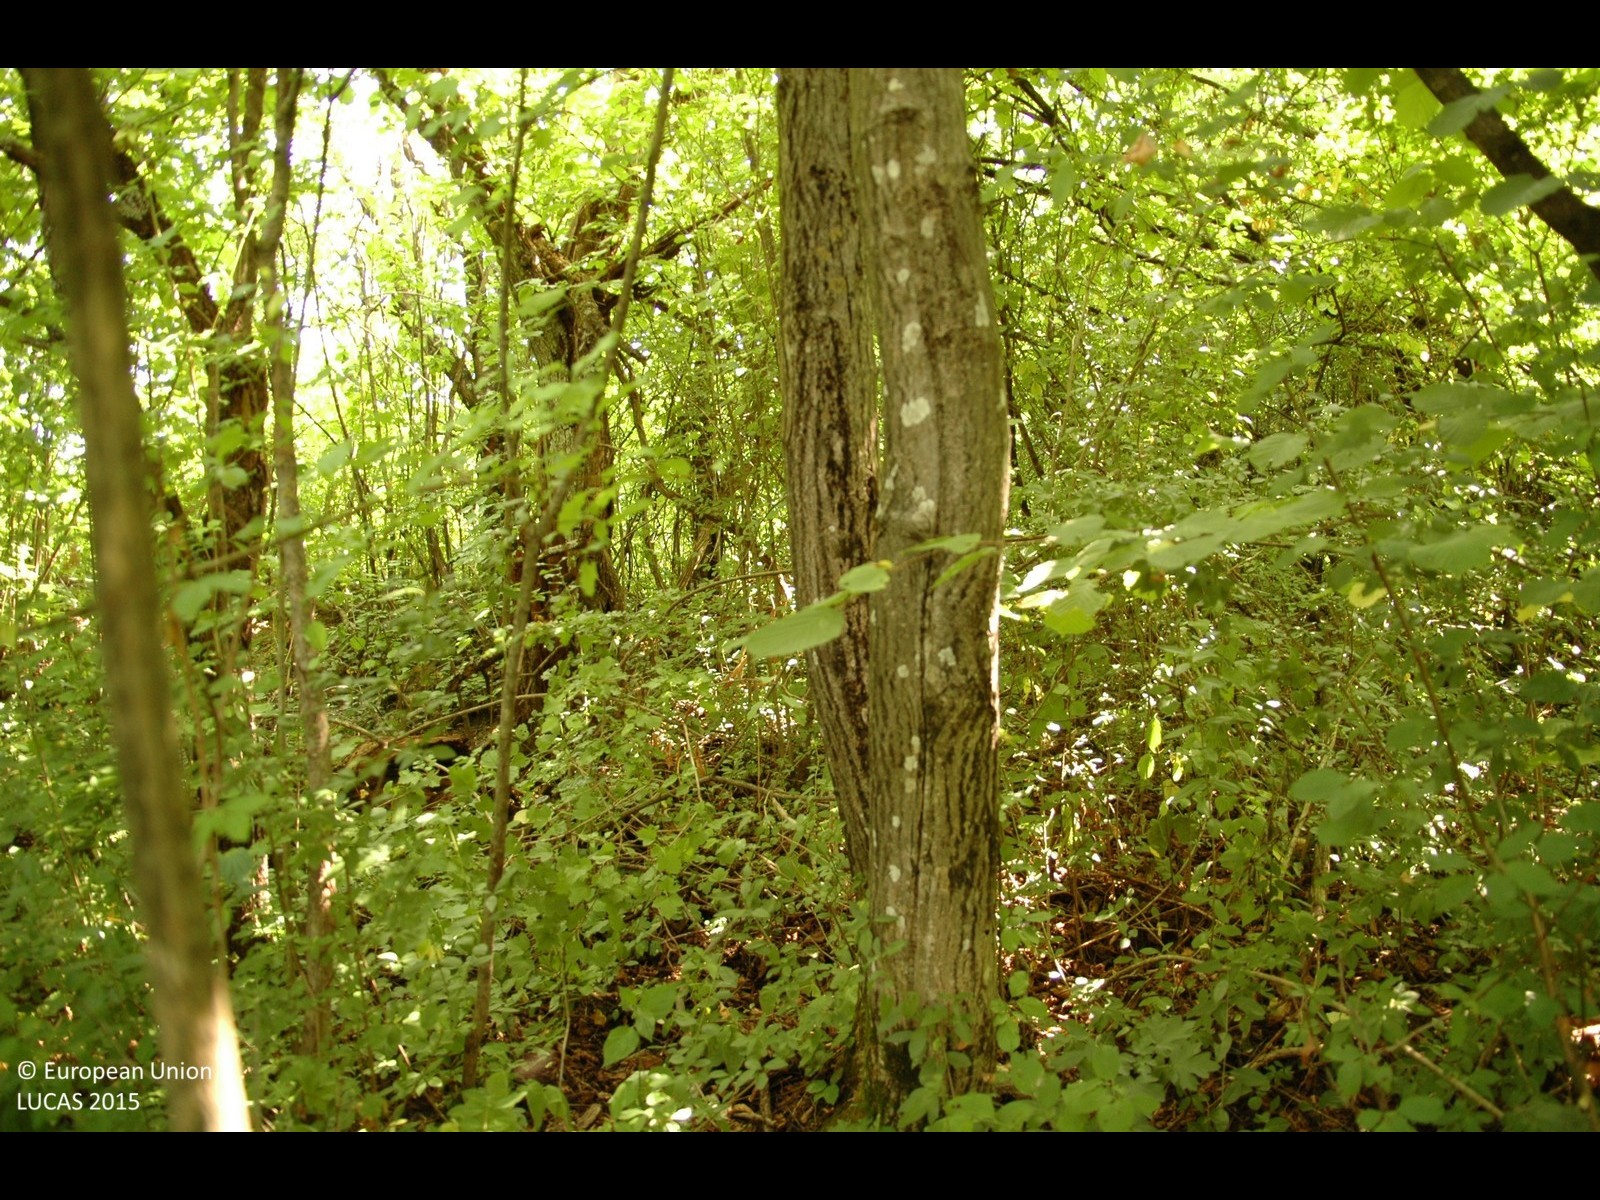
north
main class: Shrubland
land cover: Shrubland without tree cover
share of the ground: > 75 %
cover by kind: shrubs 100 %
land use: Semi-natural and natural areas not in use
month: July
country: HR
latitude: 46.1479
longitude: 16.5904
